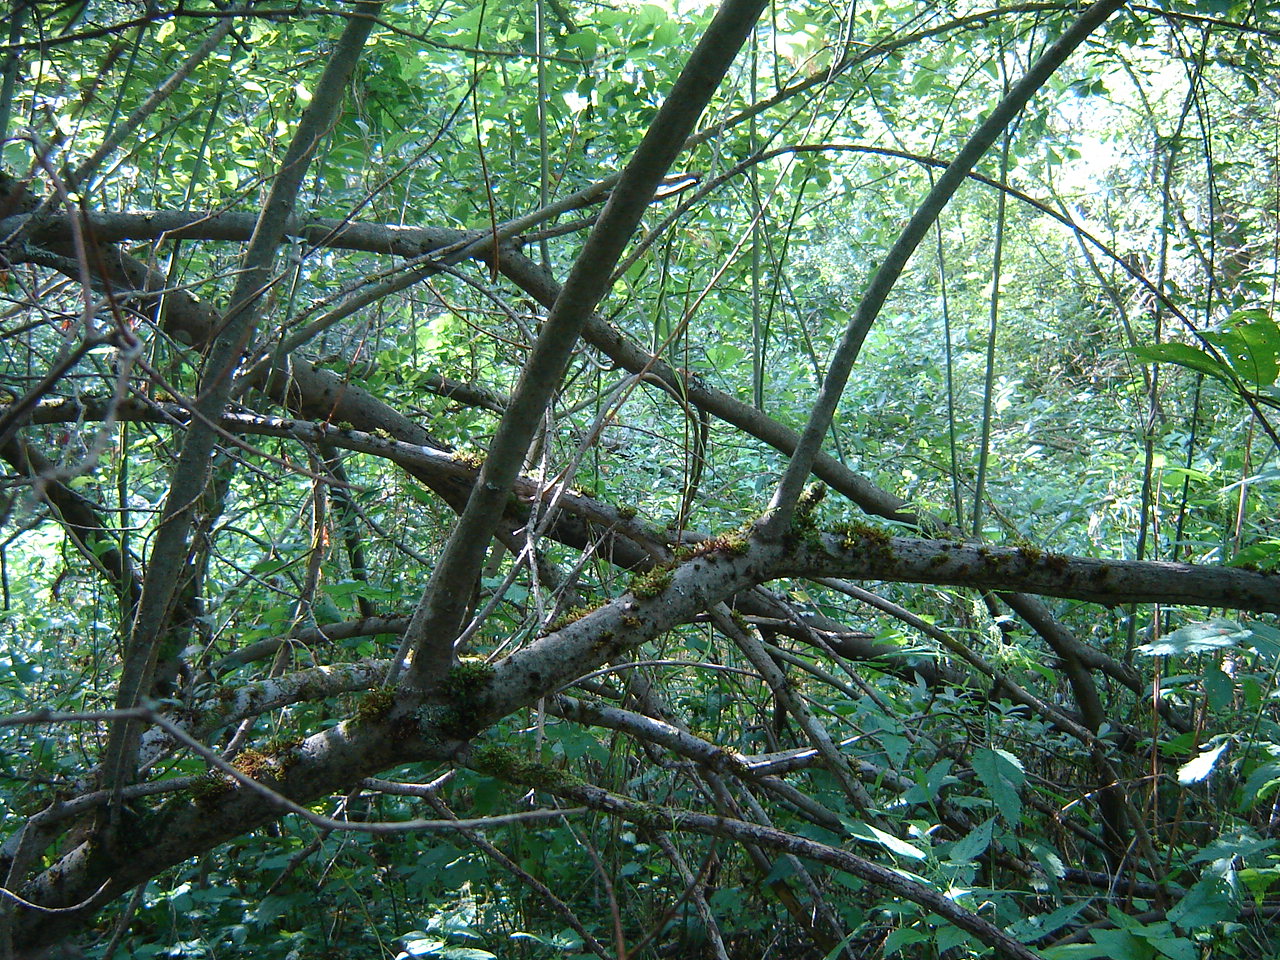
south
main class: Woodland
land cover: Broadleaved woodland
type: non-riverine alder, birch or aspen forest
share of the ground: > 75 %
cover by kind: broadleaved forest trees 85 %, herbaceous plants 15 %
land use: Forestry
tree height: > 5 m
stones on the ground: < 10 %
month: August
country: LT
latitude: 54.8400
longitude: 25.3032
